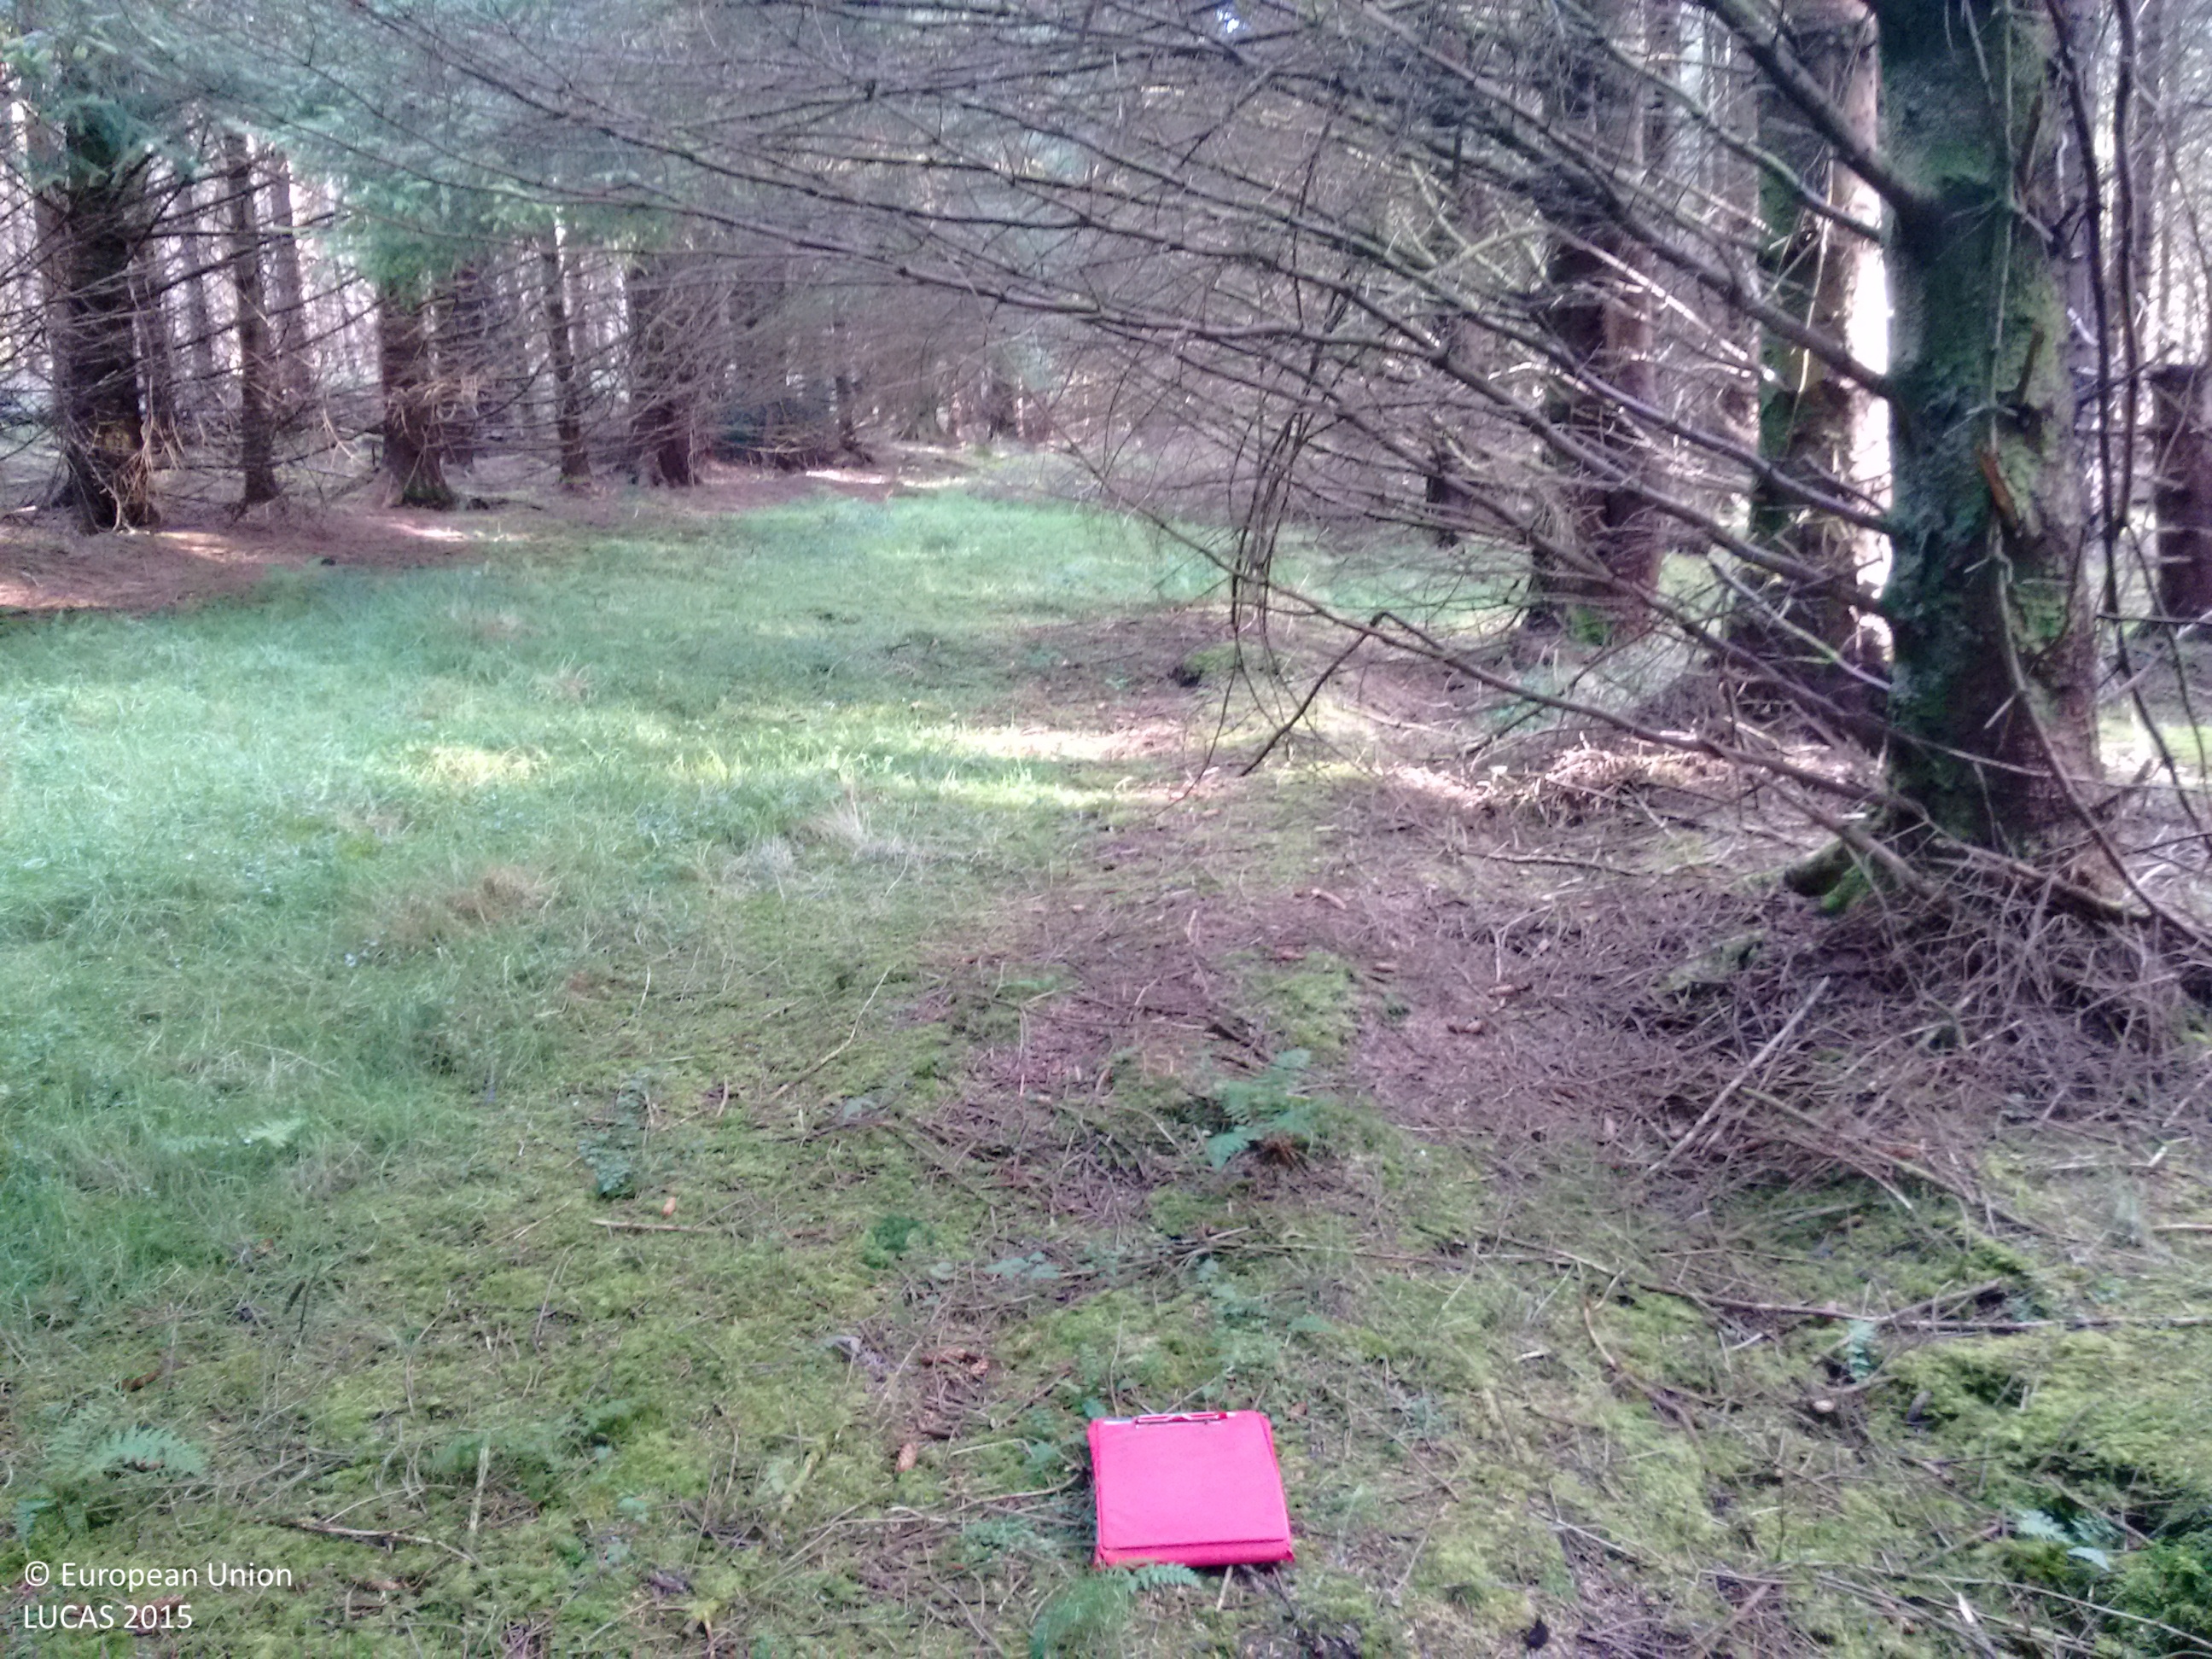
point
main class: Woodland
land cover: Spruce dominated coniferous woodland
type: exotic forest
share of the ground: > 75 %
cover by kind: coniferous forest trees 95 %, herbaceous plants 5 %
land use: Forestry
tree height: > 5 m
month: October
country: GB
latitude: 56.5419
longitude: -5.7891
